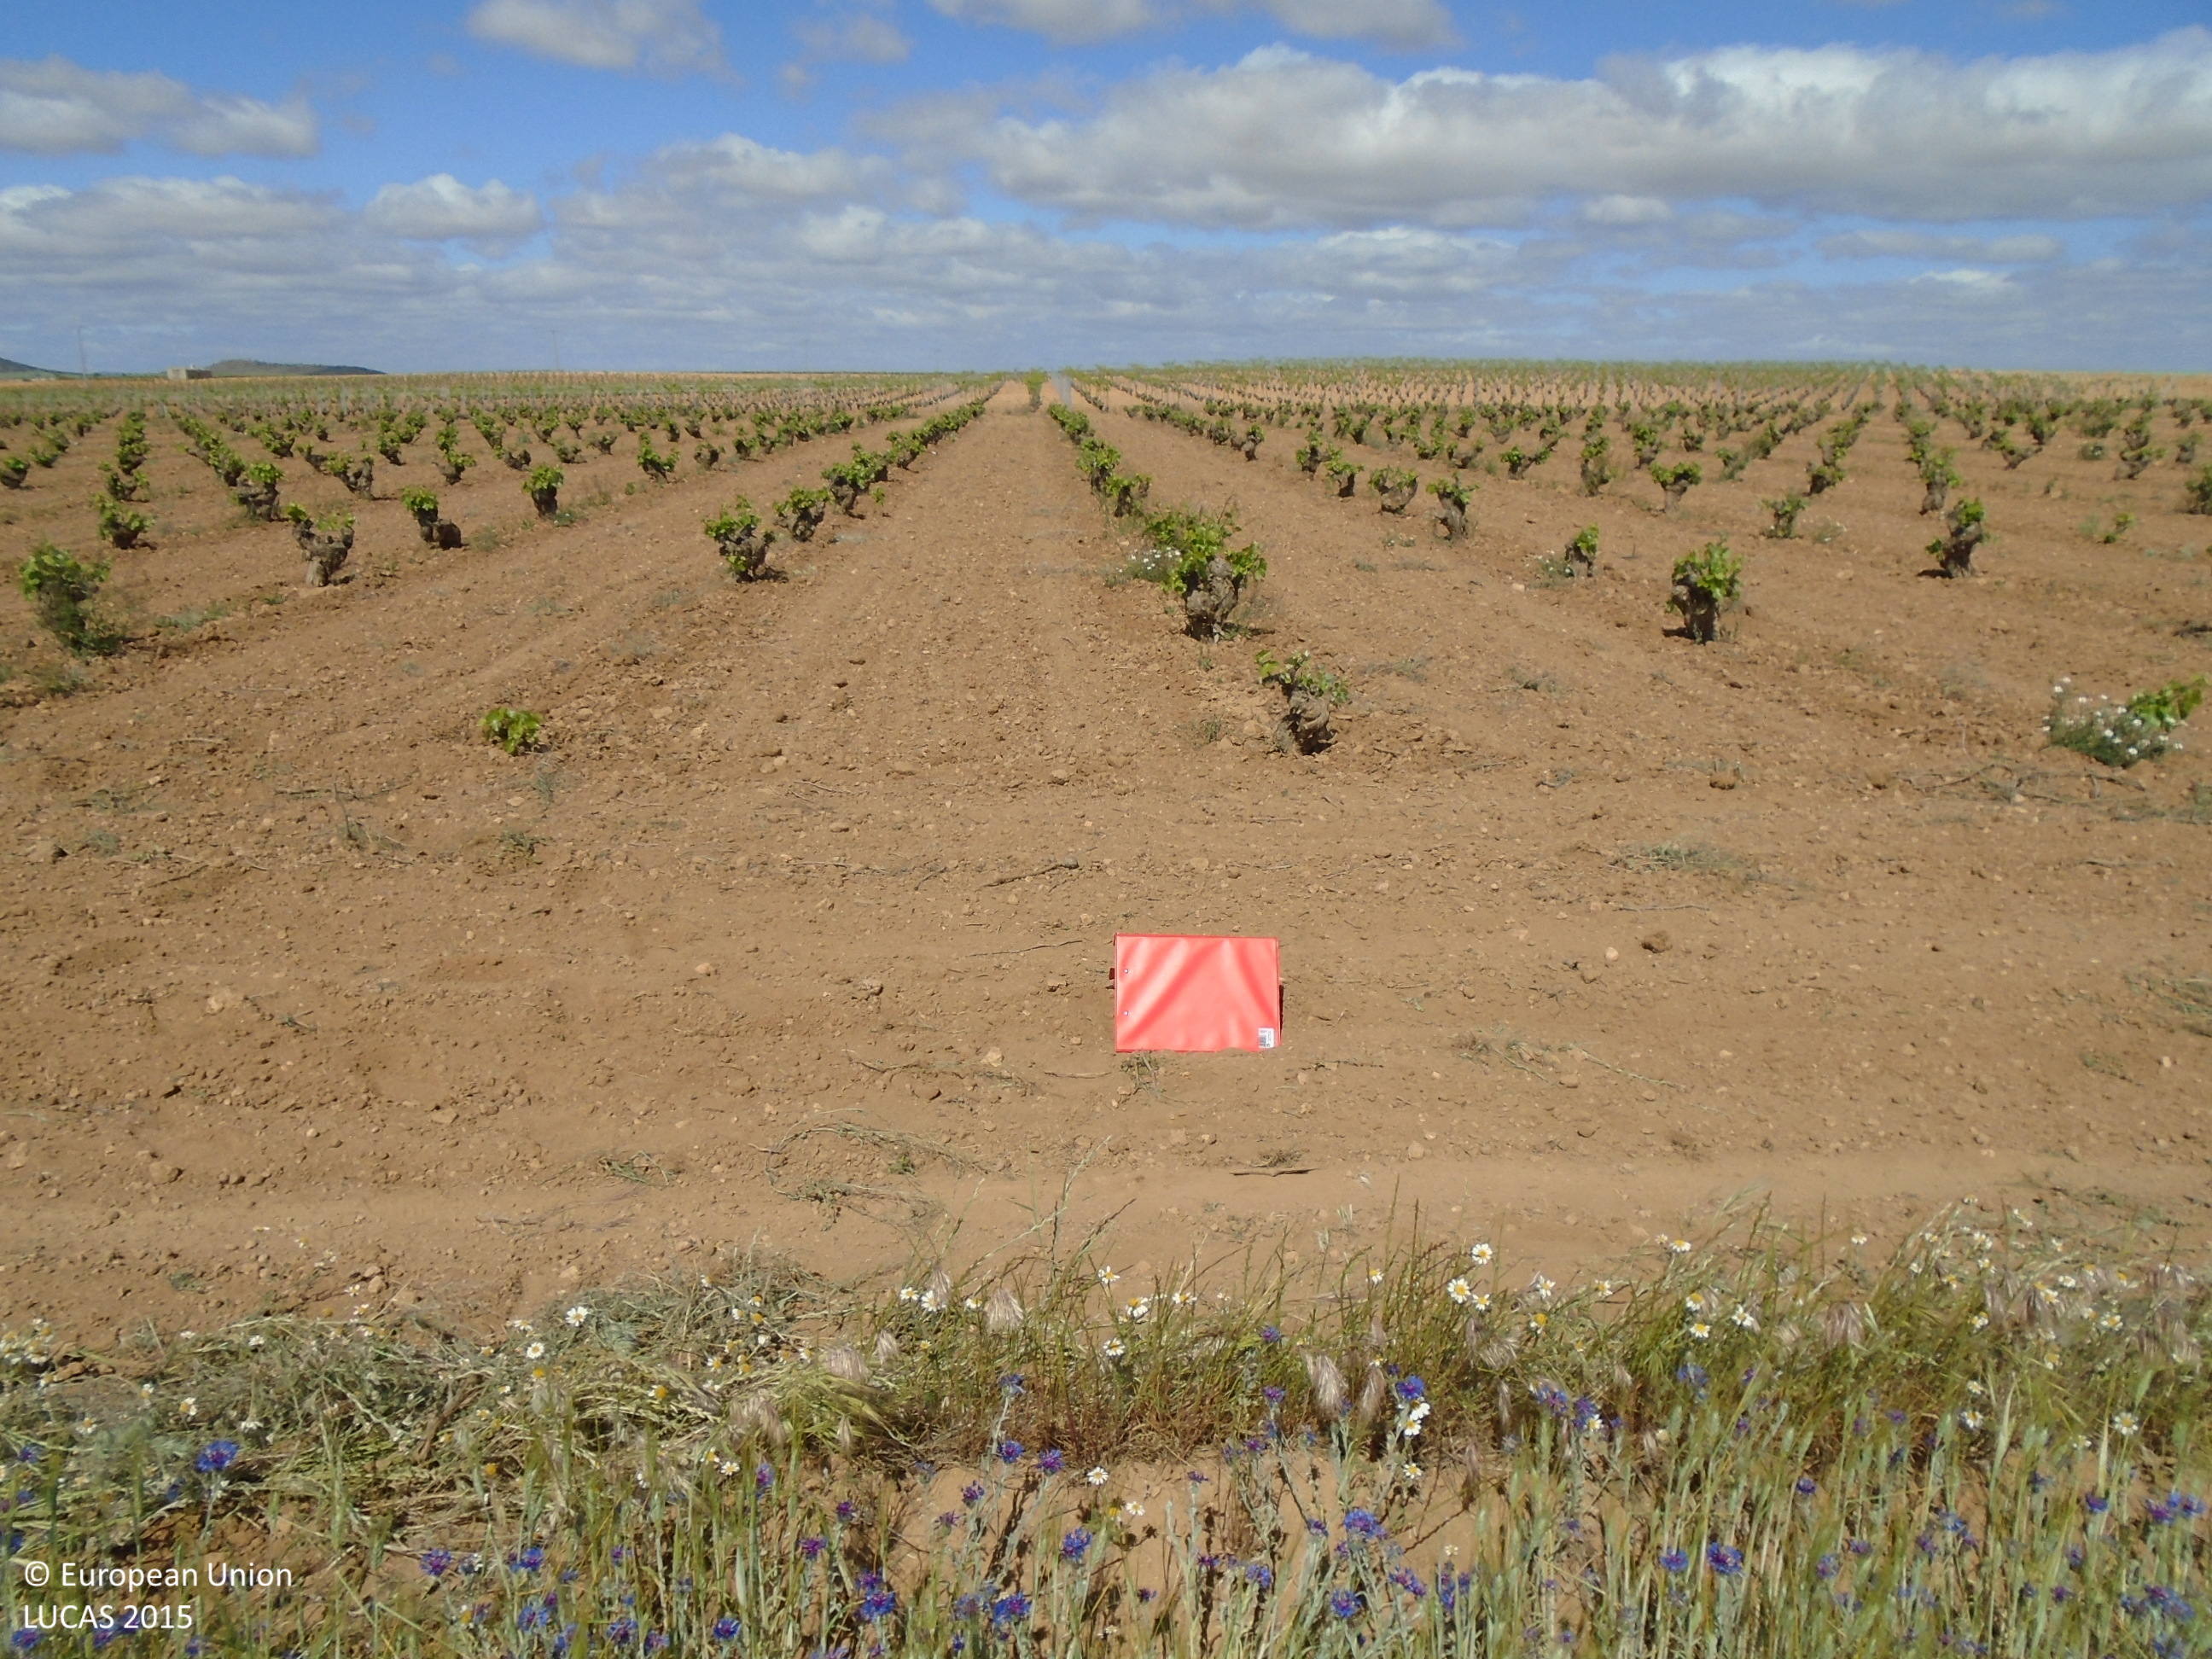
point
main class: Cropland
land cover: Vineyards
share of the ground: 10 - 25 %
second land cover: Other bare soil
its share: > 75 %
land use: Agriculture (excluding fallow land and kitchen gardens)
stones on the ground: < 10 %
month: May
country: ES
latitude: 39.5592
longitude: -3.5602
